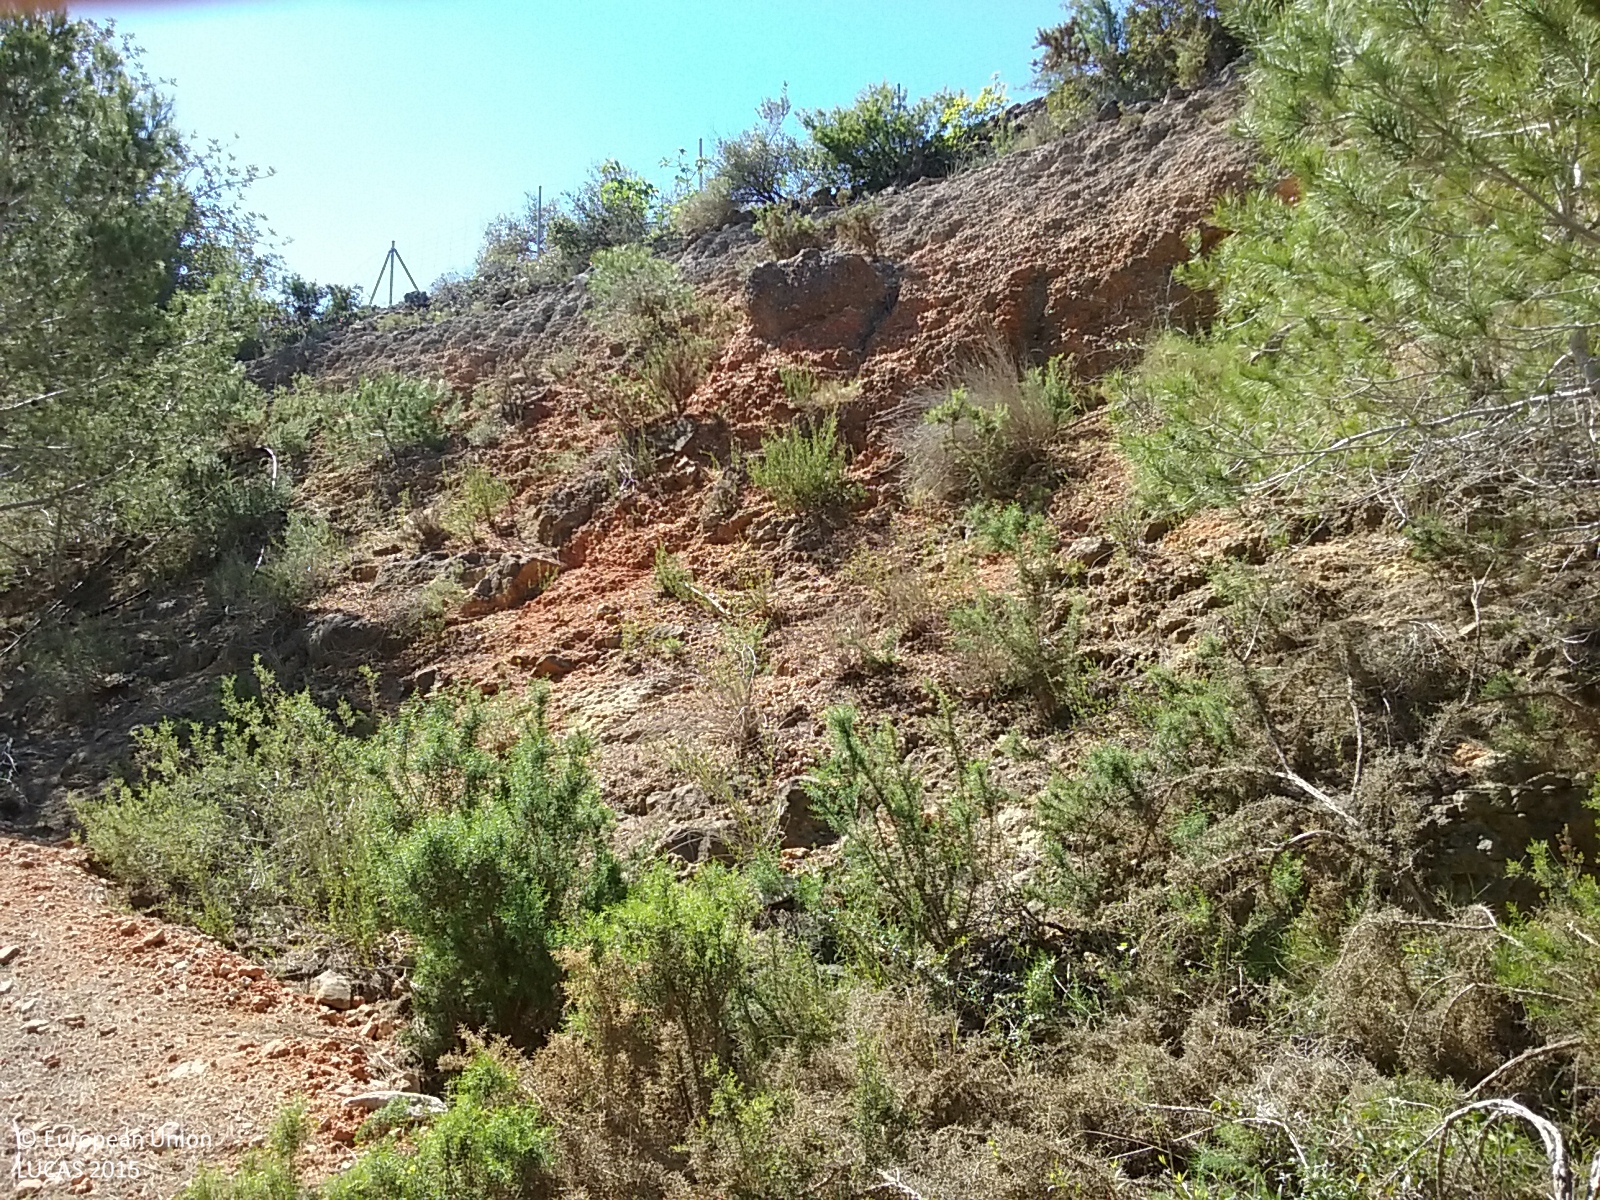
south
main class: Cropland
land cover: Permanent crops (only in case pi)
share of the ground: 25 - 50 %
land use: Agriculture (excluding fallow land and kitchen gardens)
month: April
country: ES
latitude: 40.7212
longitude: 0.5593
